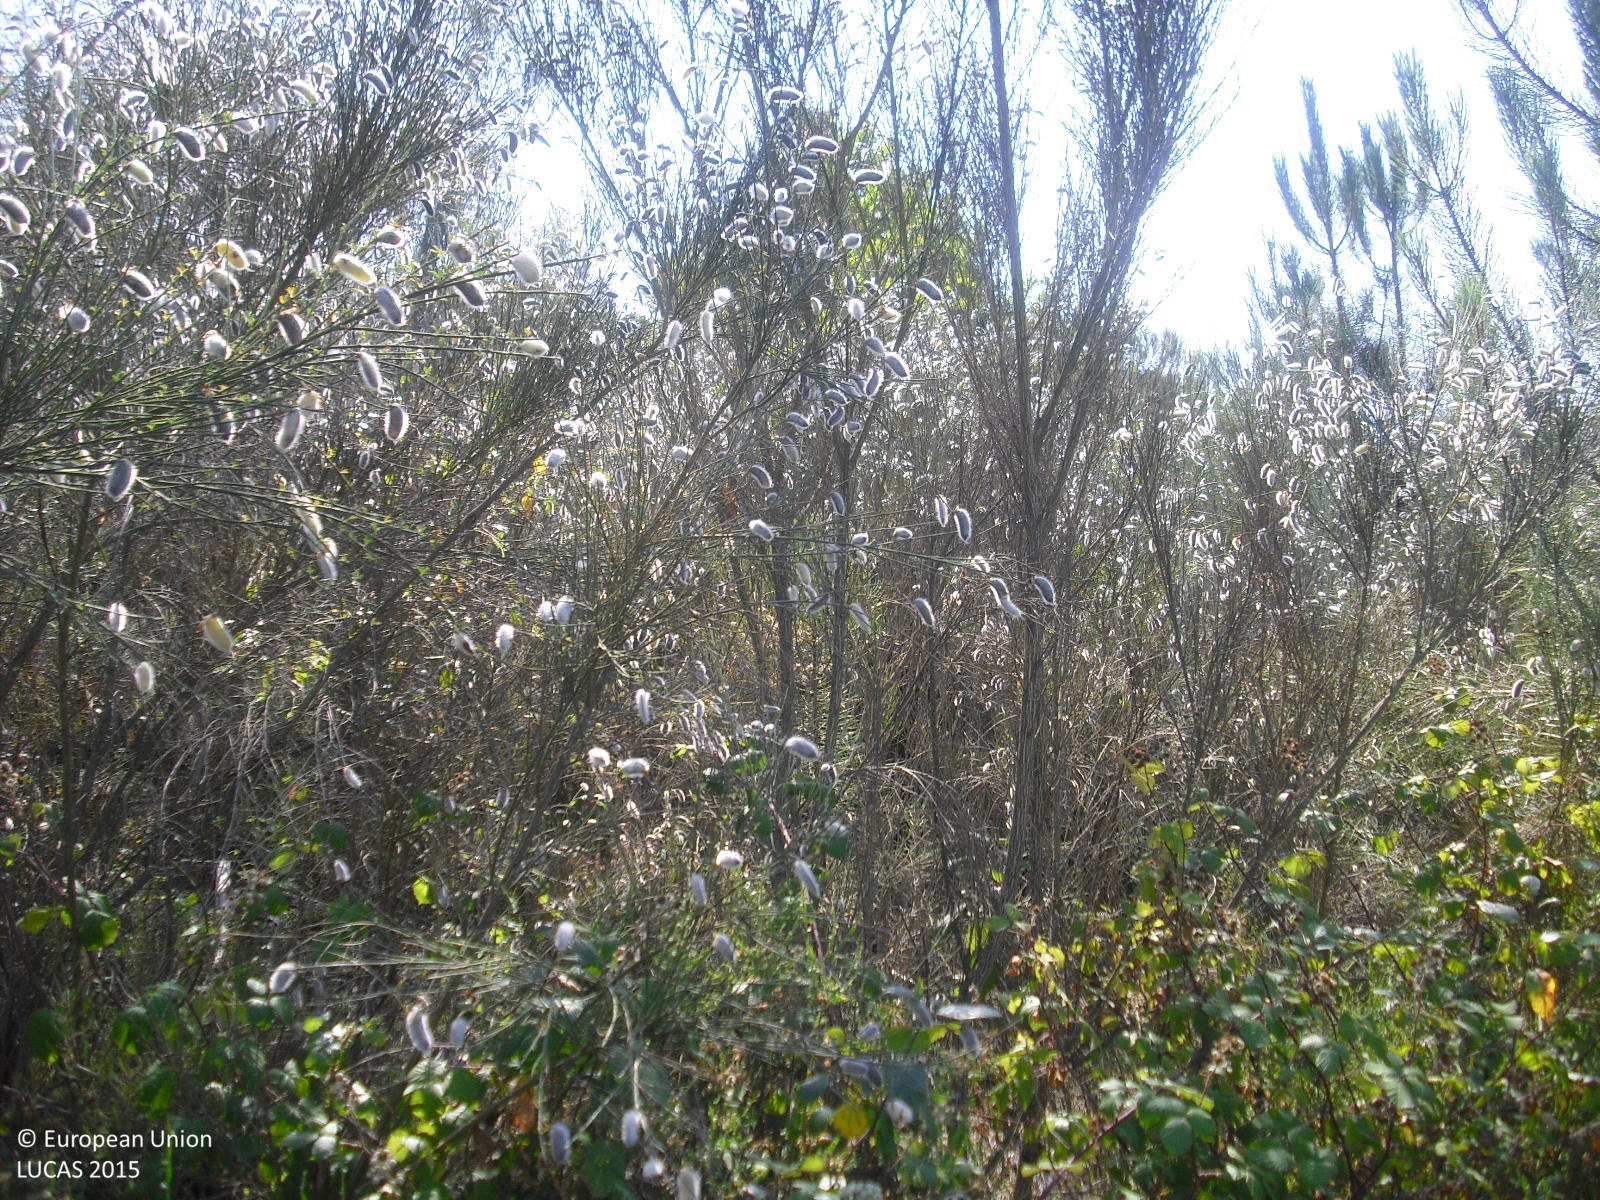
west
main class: Shrubland
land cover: Shrubland with sparse tree cover
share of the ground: > 75 %
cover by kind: shrubs 95 %, broadleaved forest trees 5 %
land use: Forestry
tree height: < 5 m
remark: Clear cut
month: July
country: ES
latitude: 42.4537
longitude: -7.4430
